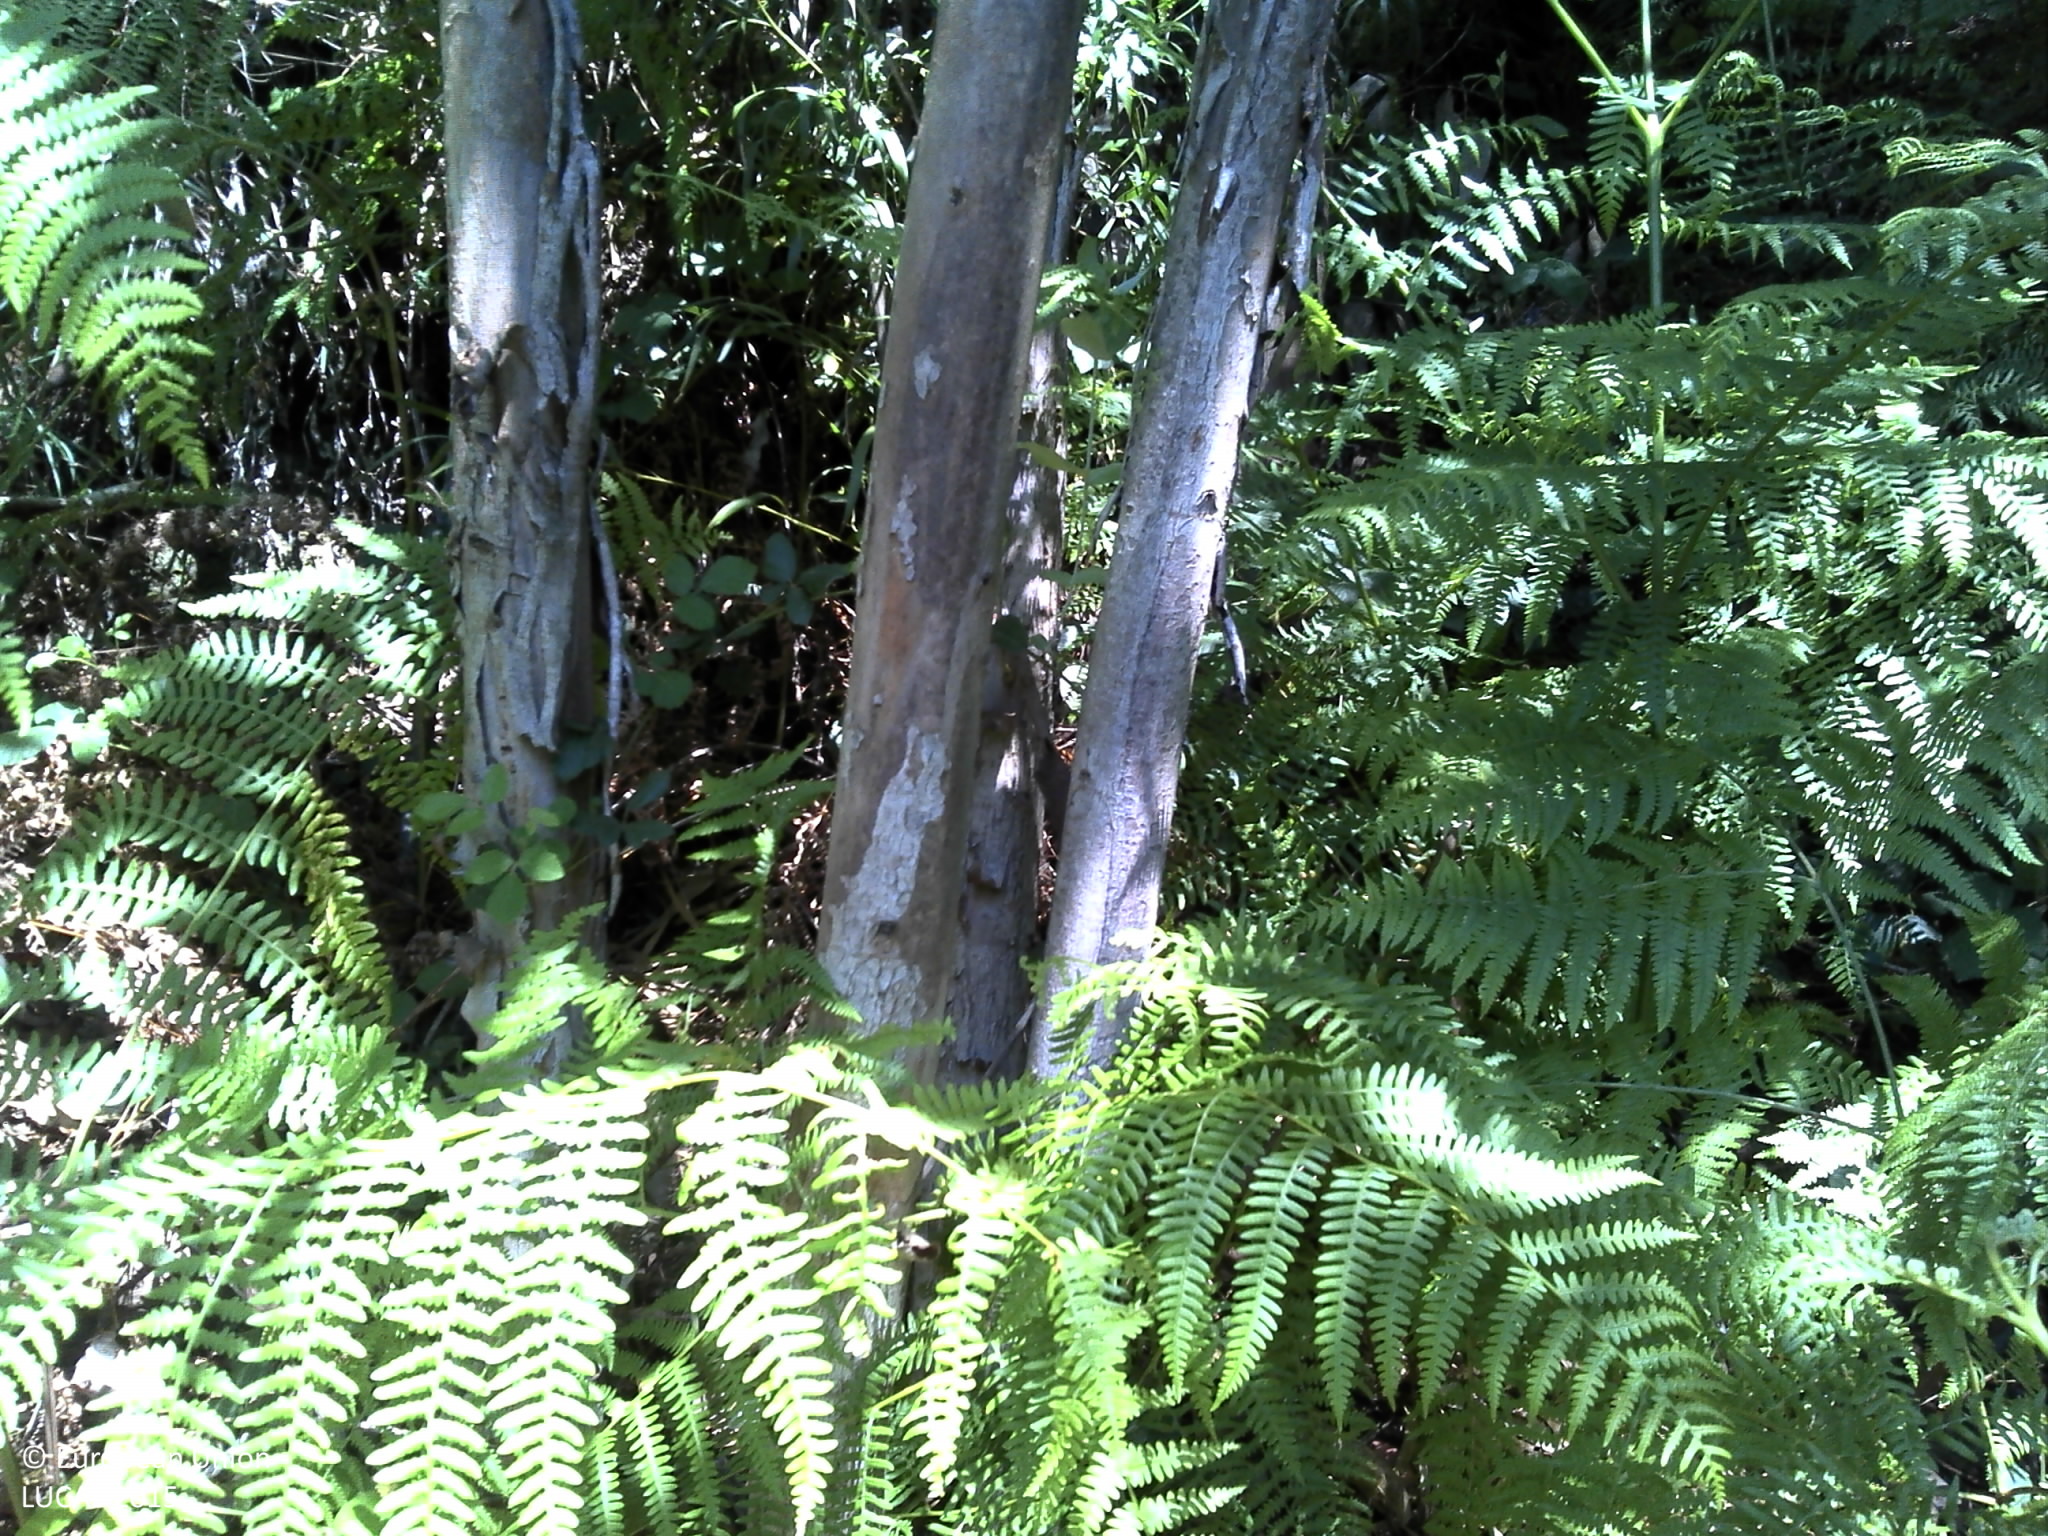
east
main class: Woodland
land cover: Broadleaved woodland
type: exotic forest
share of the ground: 50 - 75 %
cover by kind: broadleaved forest trees 50 %, shrubs 25 %, unconsolidated bare surface 25 %
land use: Forestry
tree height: > 5 m
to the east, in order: Broadleaved woodland; Tracks; Broadleaved woodland; Paved roads, cycling and walking lanes; Broadleaved woodland; Artificial constructions in urban areas; Broadleaved woodland; Paved roads, cycling and walking lanes; Shrubland without tree cover; Broadleaved woodland; Paved roads, cycling and walking lanes
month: May
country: PT
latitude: 41.7805
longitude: -8.6074
